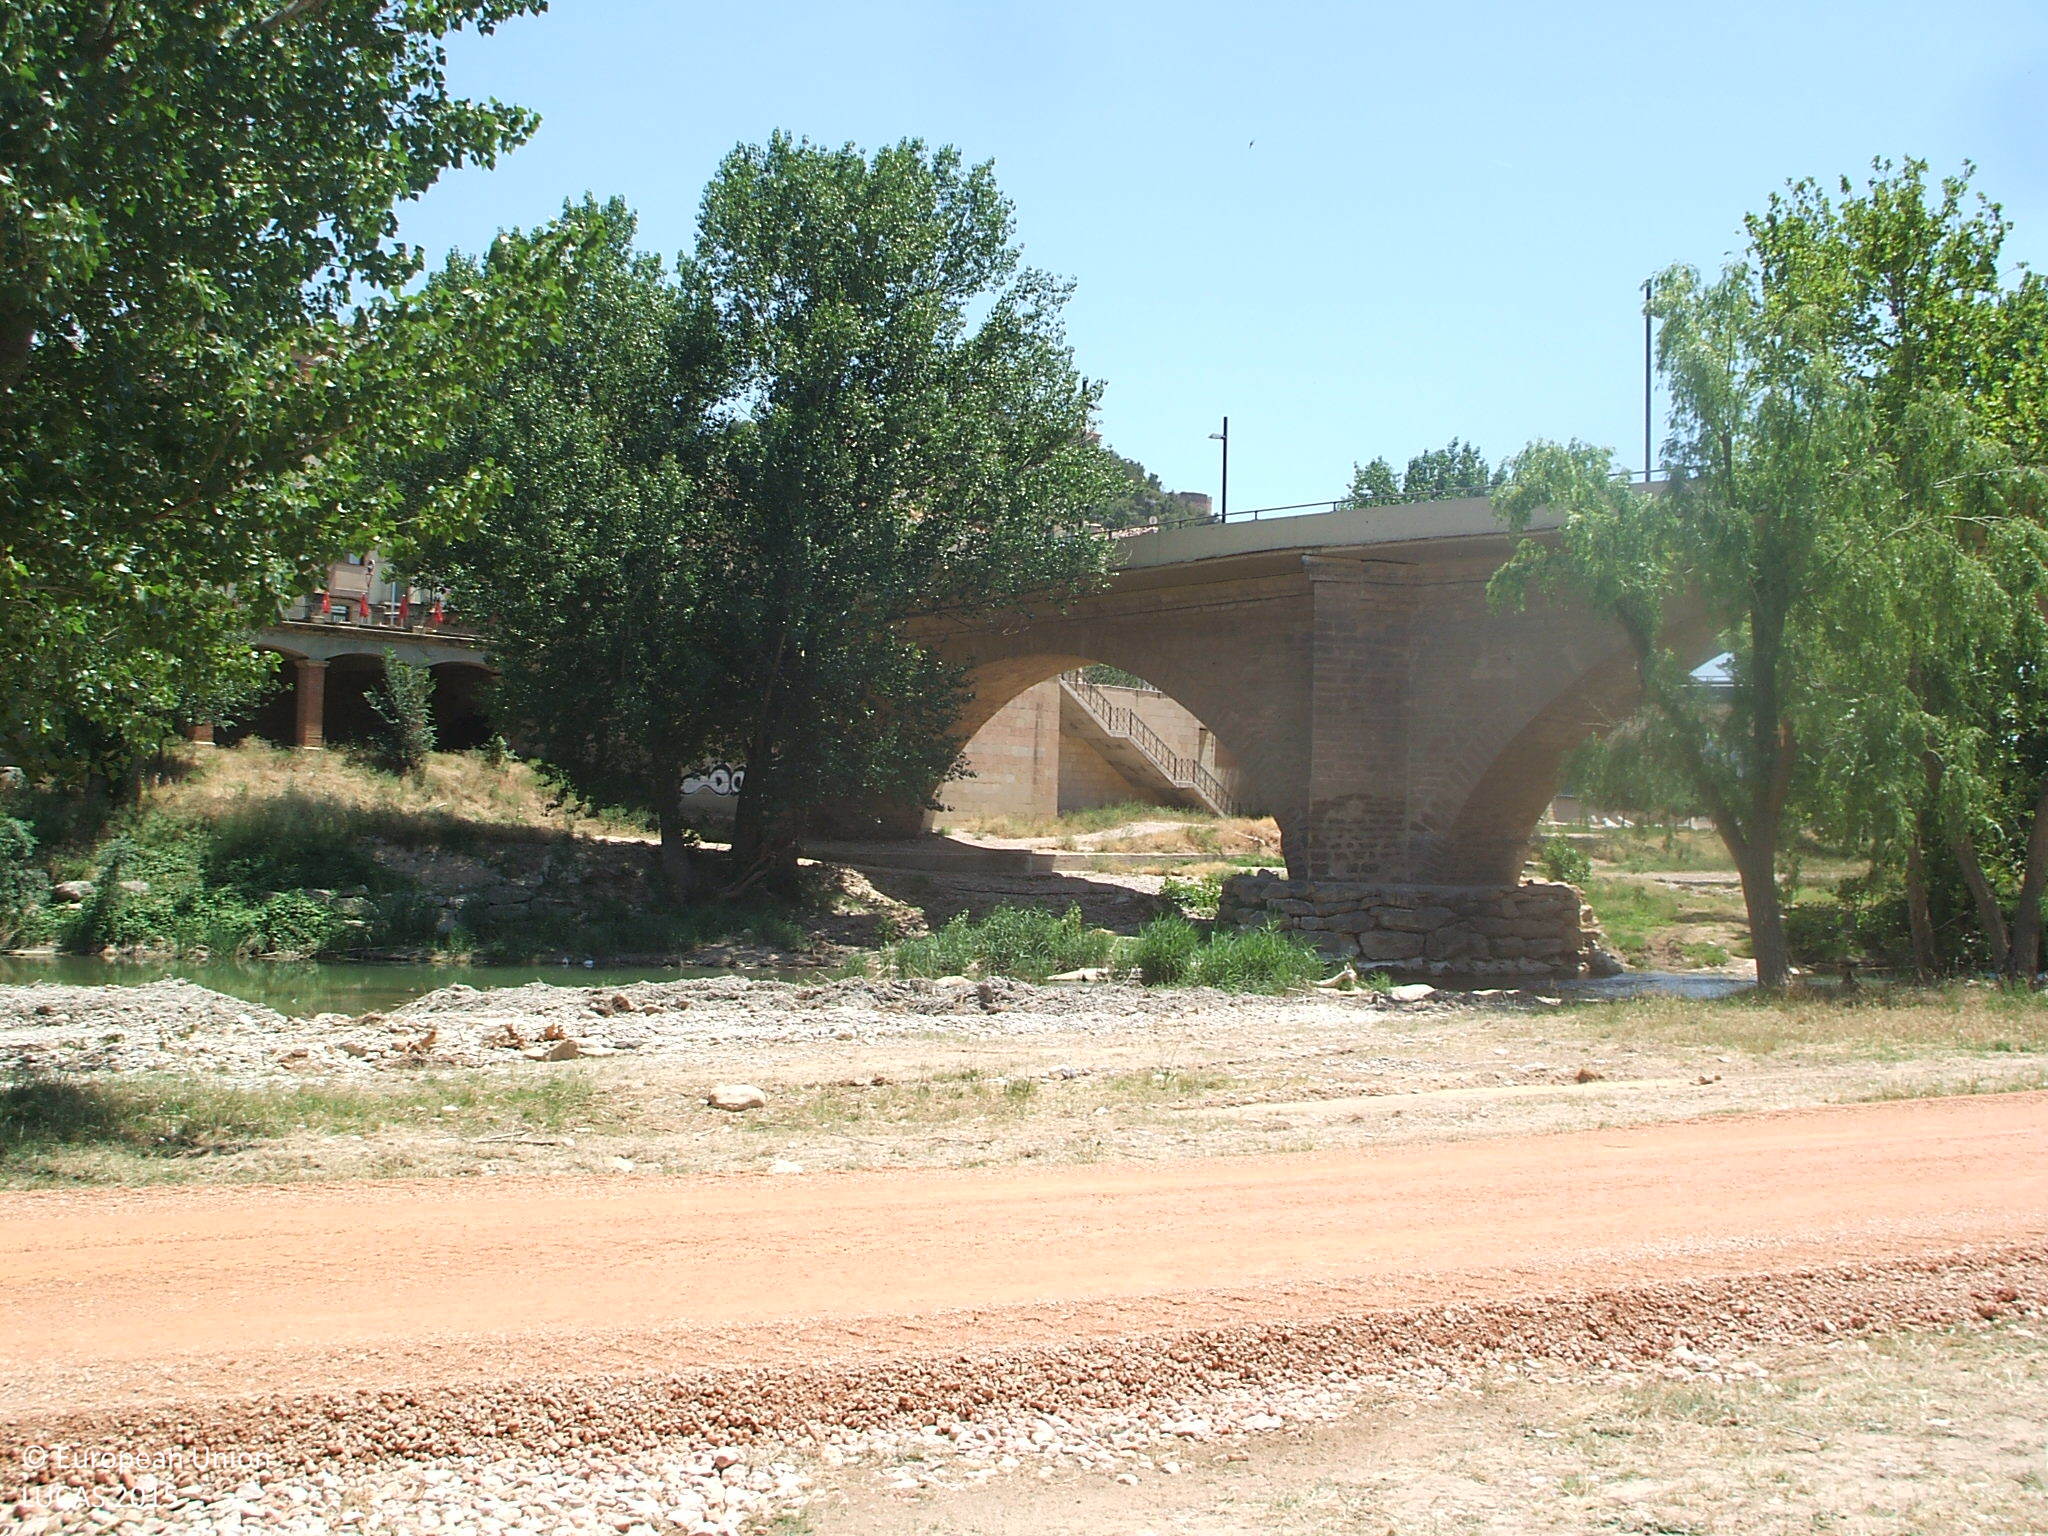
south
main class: Woodland
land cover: Broadleaved woodland
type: exotic forest
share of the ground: 50 - 75 %
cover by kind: broadleaved forest trees 60 %, unconsolidated bare surface 30 %, herbaceous plants 10 %
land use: Amenities, museums, leisure
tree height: > 5 m
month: June
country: ES
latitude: 41.0524
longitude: -0.1366
